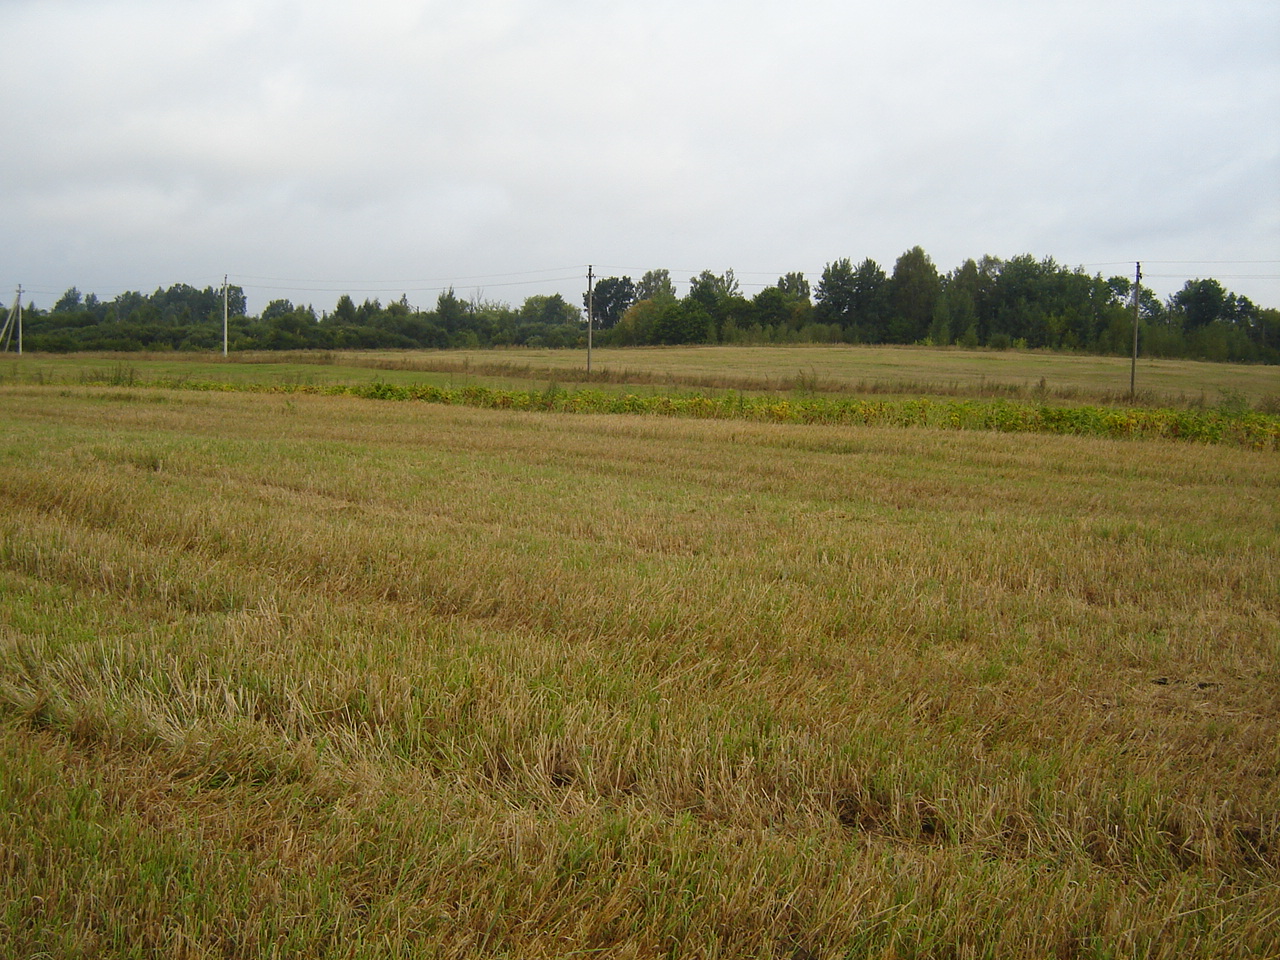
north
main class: Cropland
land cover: Barley
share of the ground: > 75 %
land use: Agriculture (excluding fallow land and kitchen gardens)
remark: Harvested field
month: August
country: LT
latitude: 54.7696
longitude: 24.8302
